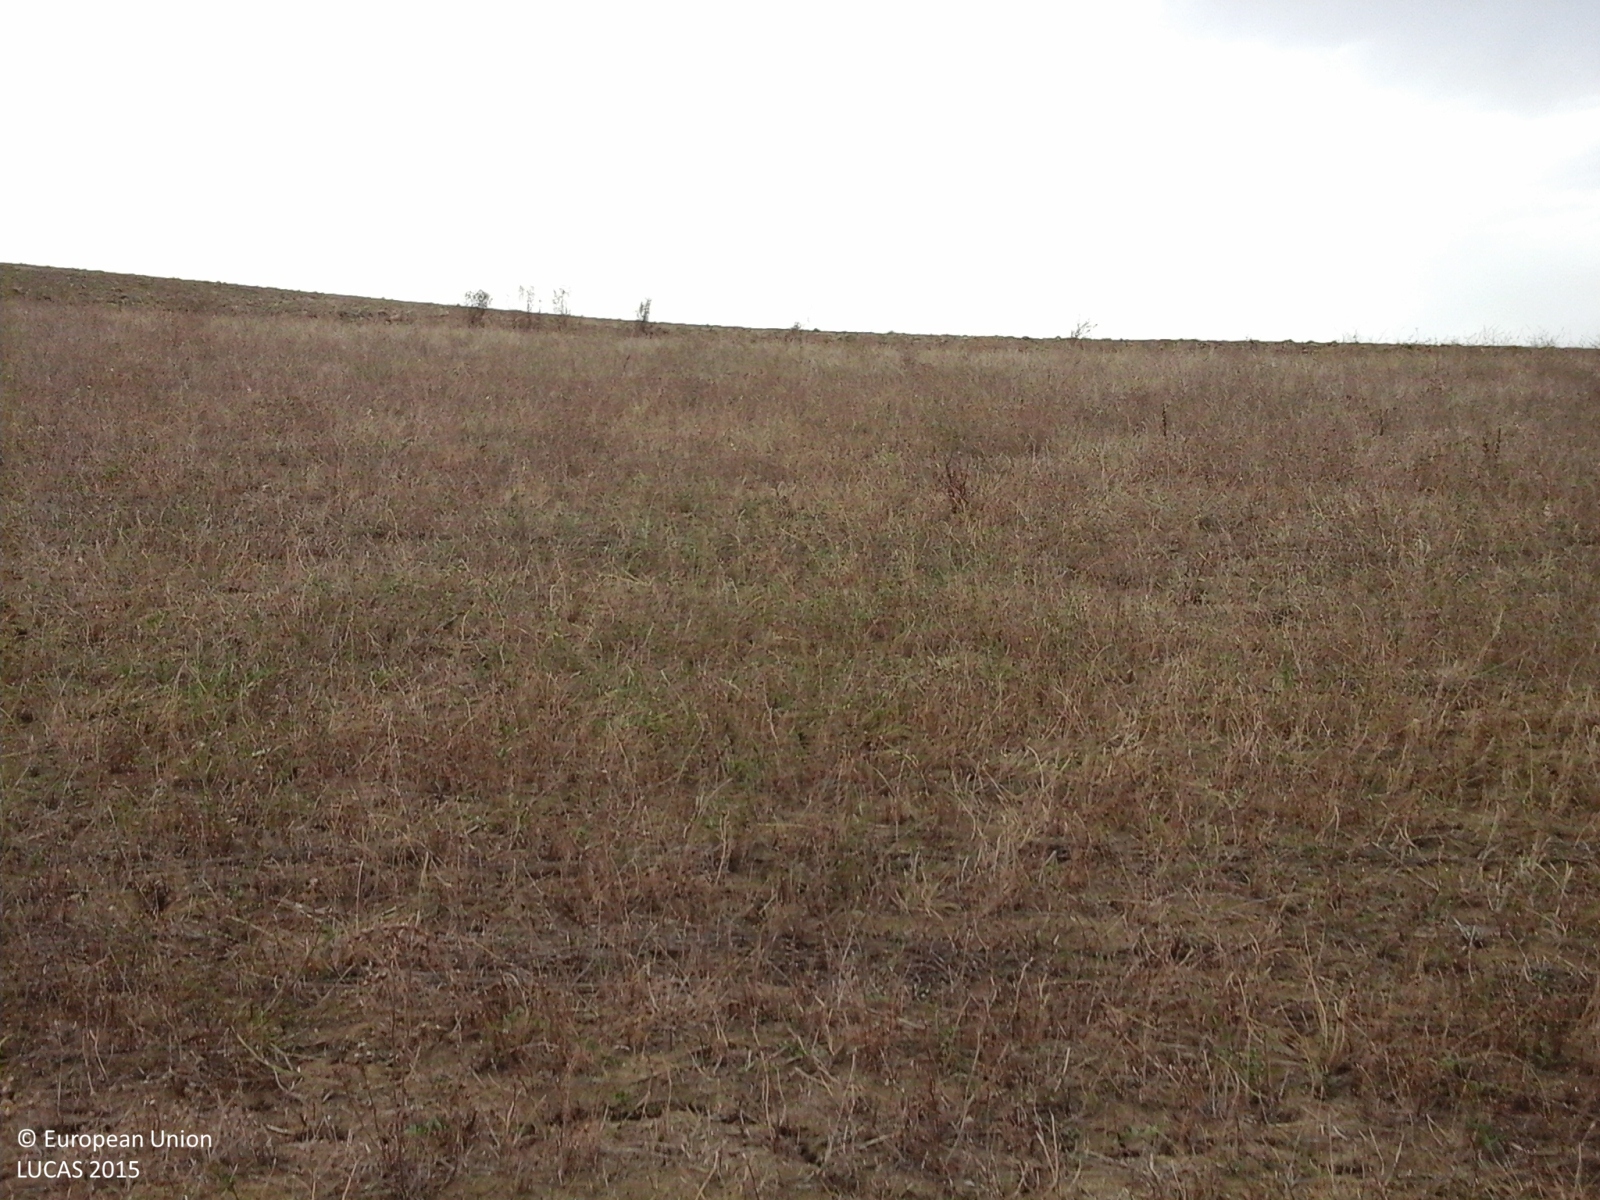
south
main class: Cropland
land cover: Temporary grasslands
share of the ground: > 75 %
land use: Agriculture (excluding fallow land and kitchen gardens)
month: September
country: IT
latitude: 41.8353
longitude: 15.1499
